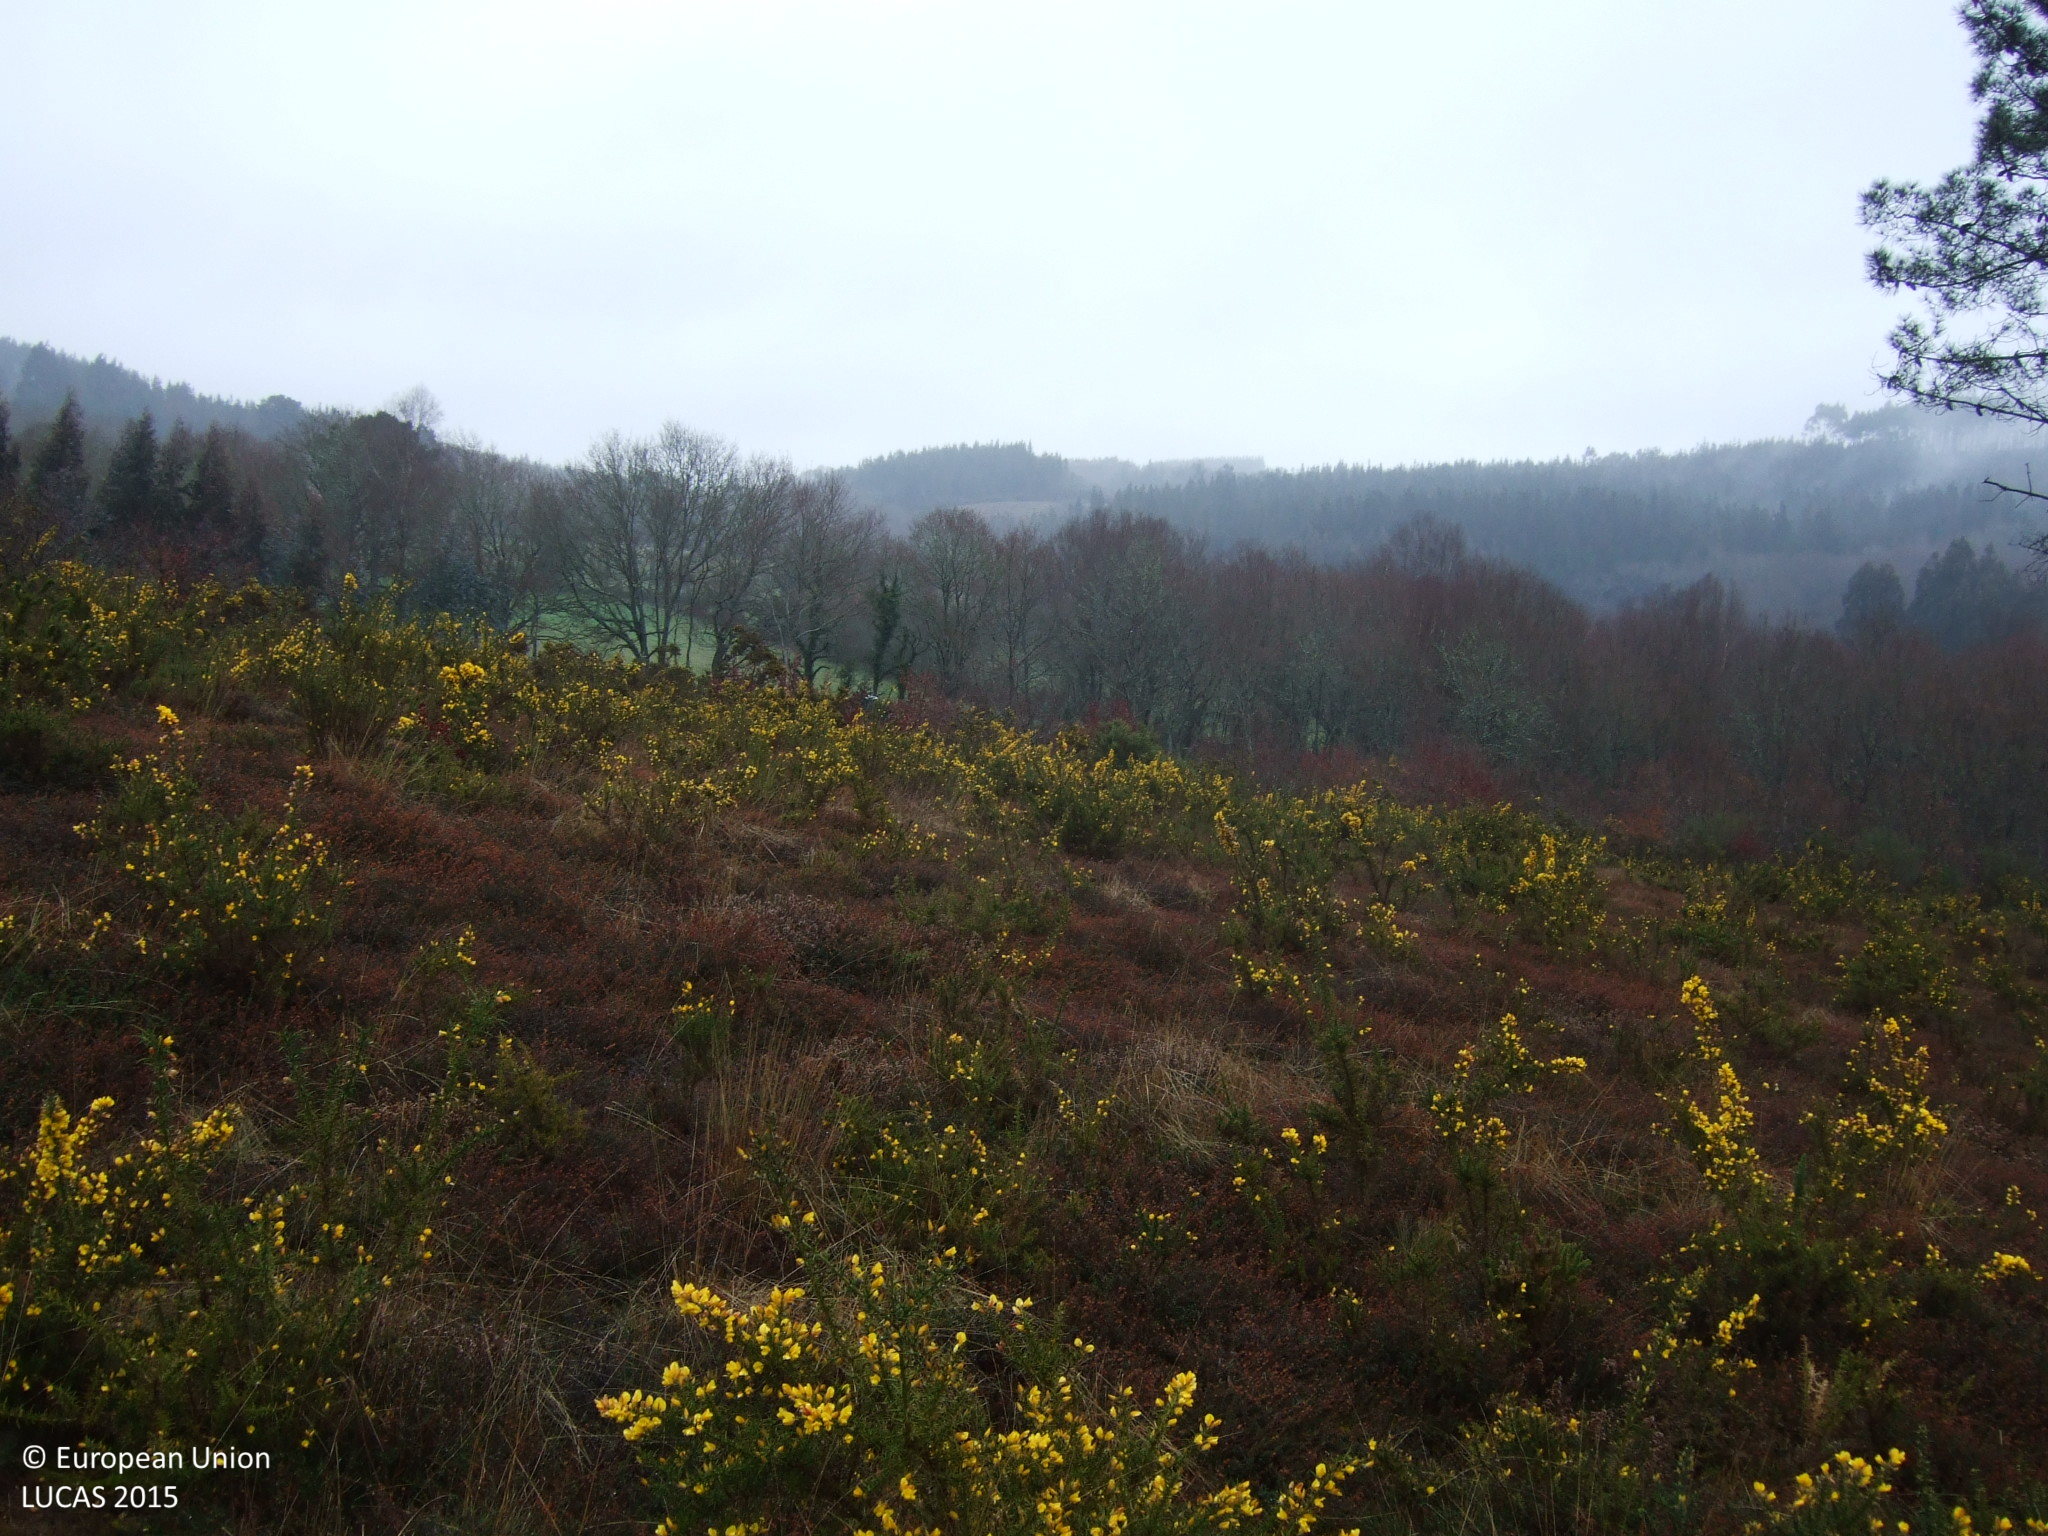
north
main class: Shrubland
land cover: Shrubland without tree cover
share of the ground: > 75 %
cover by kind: shrubs 100 %
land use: Semi-natural and natural areas not in use
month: March
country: ES
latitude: 42.8624
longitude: -7.8429
